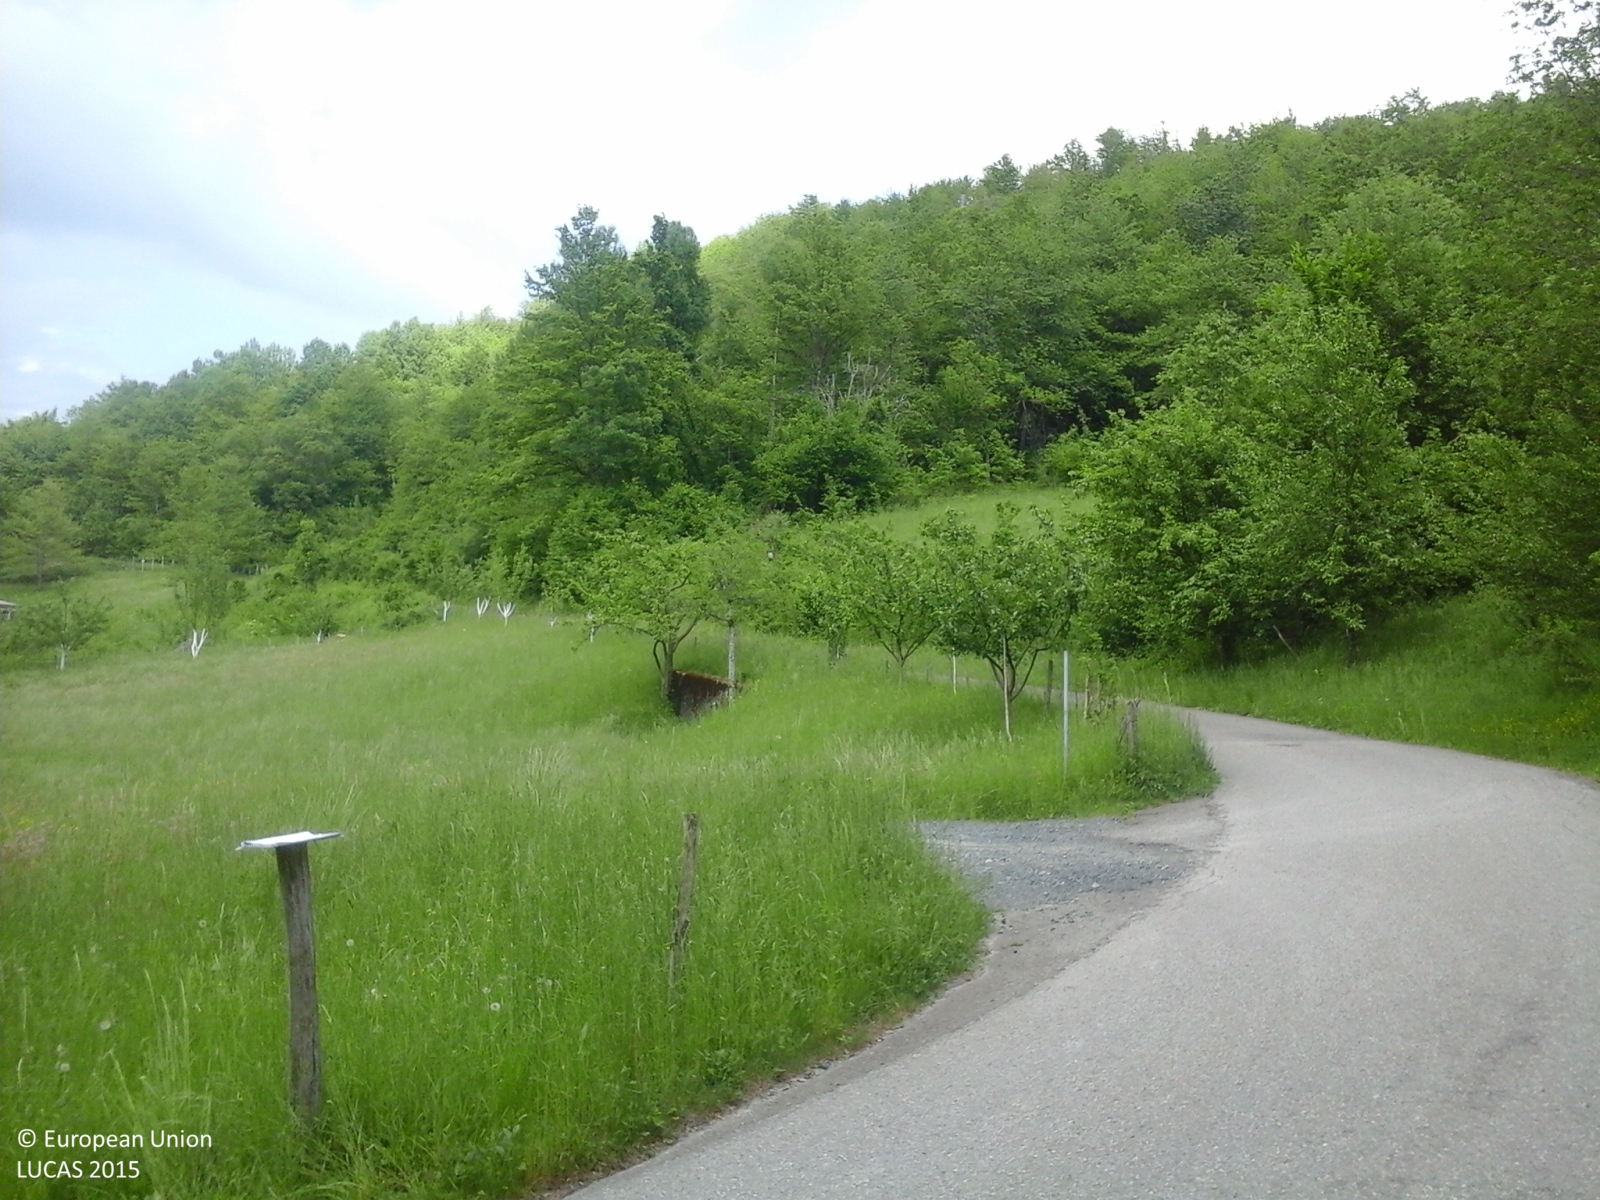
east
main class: Woodland
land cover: Broadleaved woodland
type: thermophilous deciduous forest
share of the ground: > 75 %
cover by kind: broadleaved forest trees 70 %, shrubs 30 %
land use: Forestry
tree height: > 5 m
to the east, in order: Broadleaved woodland
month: May
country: IT
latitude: 44.4761
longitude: 9.6111
